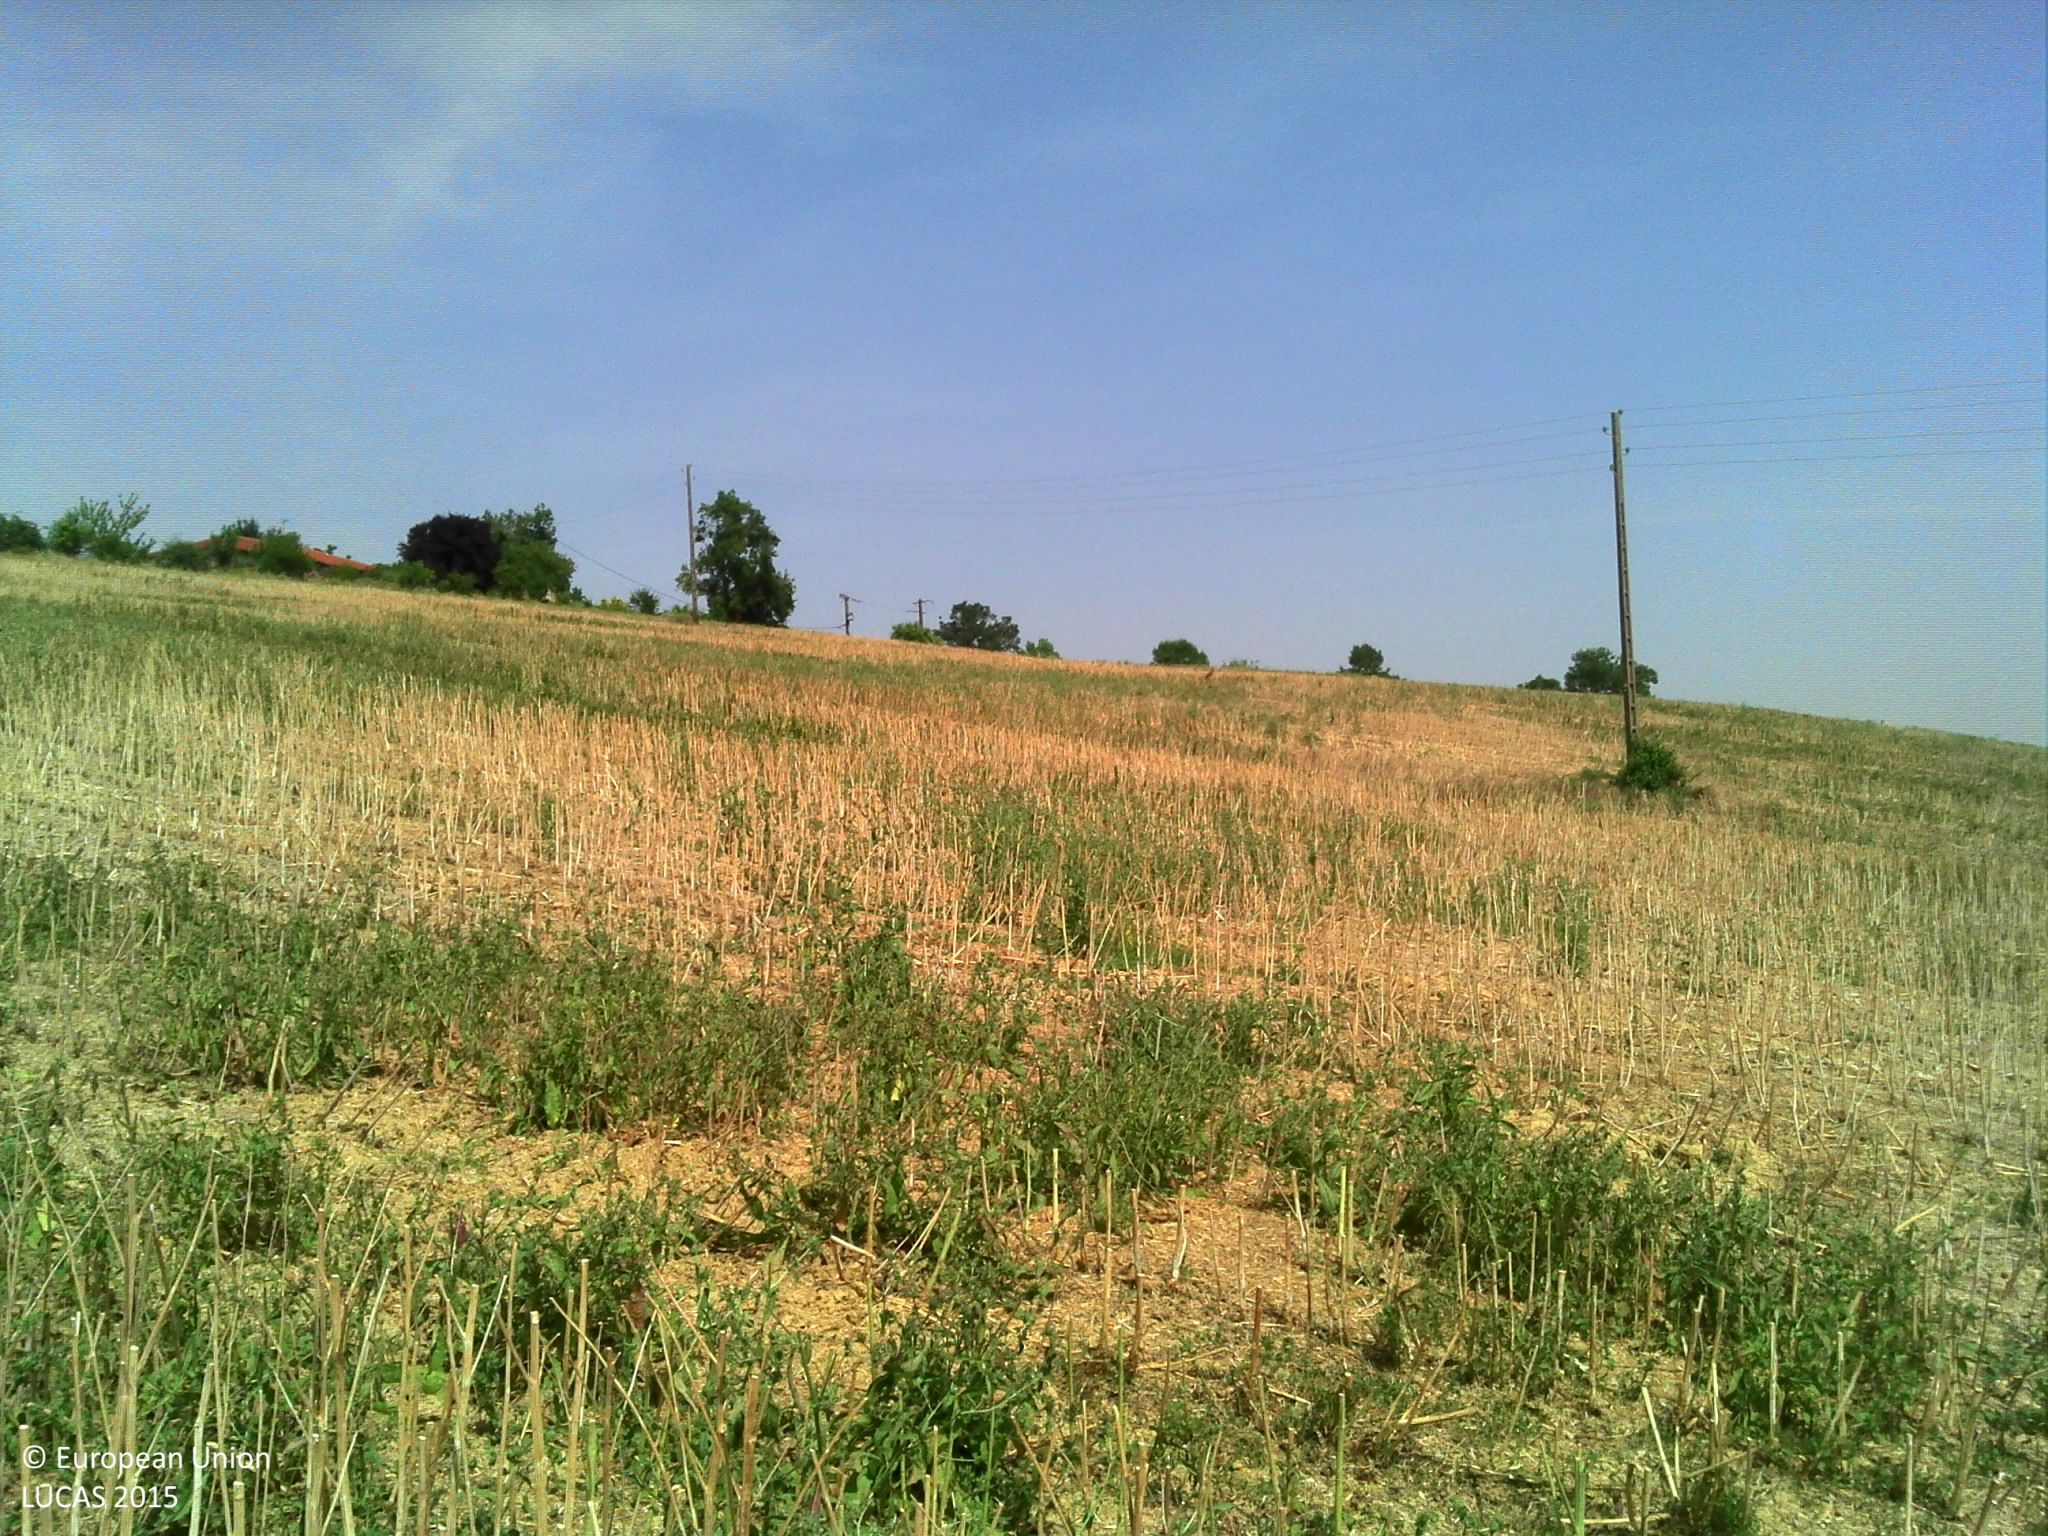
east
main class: Cropland
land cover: Rape and turnip rape
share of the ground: 10 - 25 %
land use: Agriculture (excluding fallow land and kitchen gardens)
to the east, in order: Rape and turnip rape; Electric lines; Rape and turnip rape; Spontaneously vegetated surfaces; Shruby margins; Grassland without tree/shrub cover; Electric lines; Spontaneously vegetated surfaces; Broadleaved woodland
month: July
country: FR
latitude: 43.6449
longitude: 0.9374
